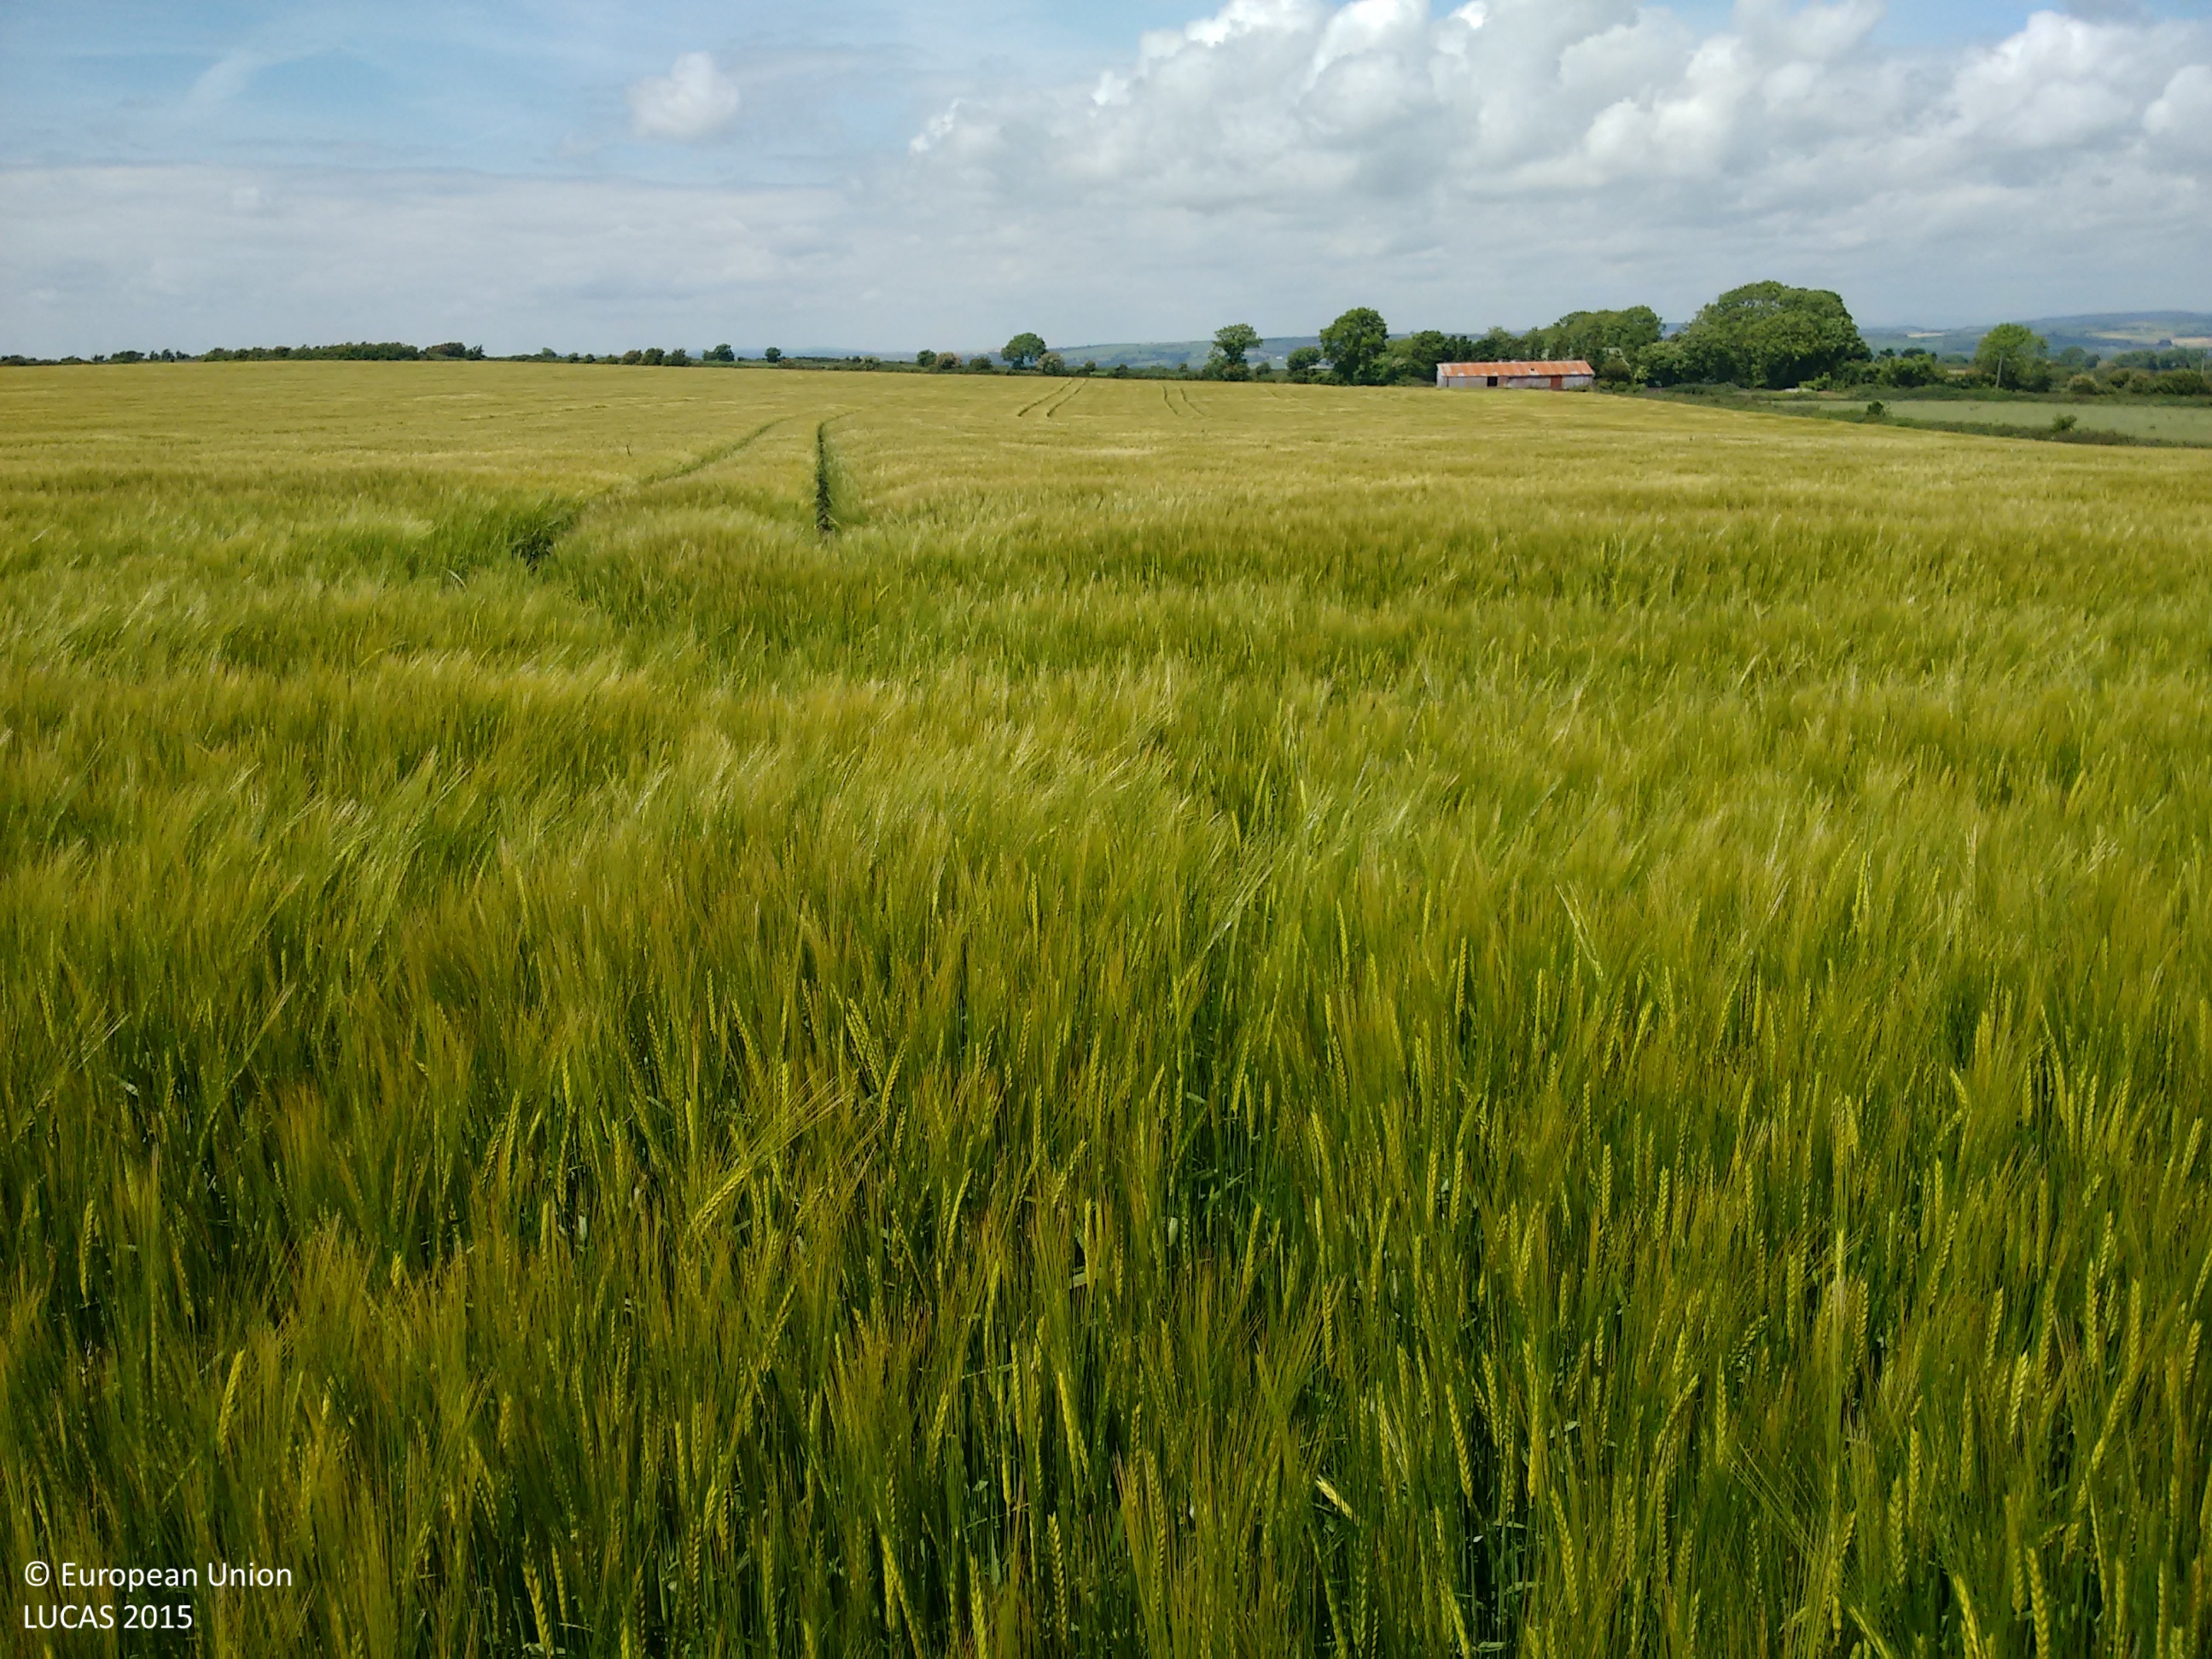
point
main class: Cropland
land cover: Common wheat
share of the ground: > 75 %
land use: Agriculture (excluding fallow land and kitchen gardens)
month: June
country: IE
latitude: 51.8790
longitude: -8.0605
